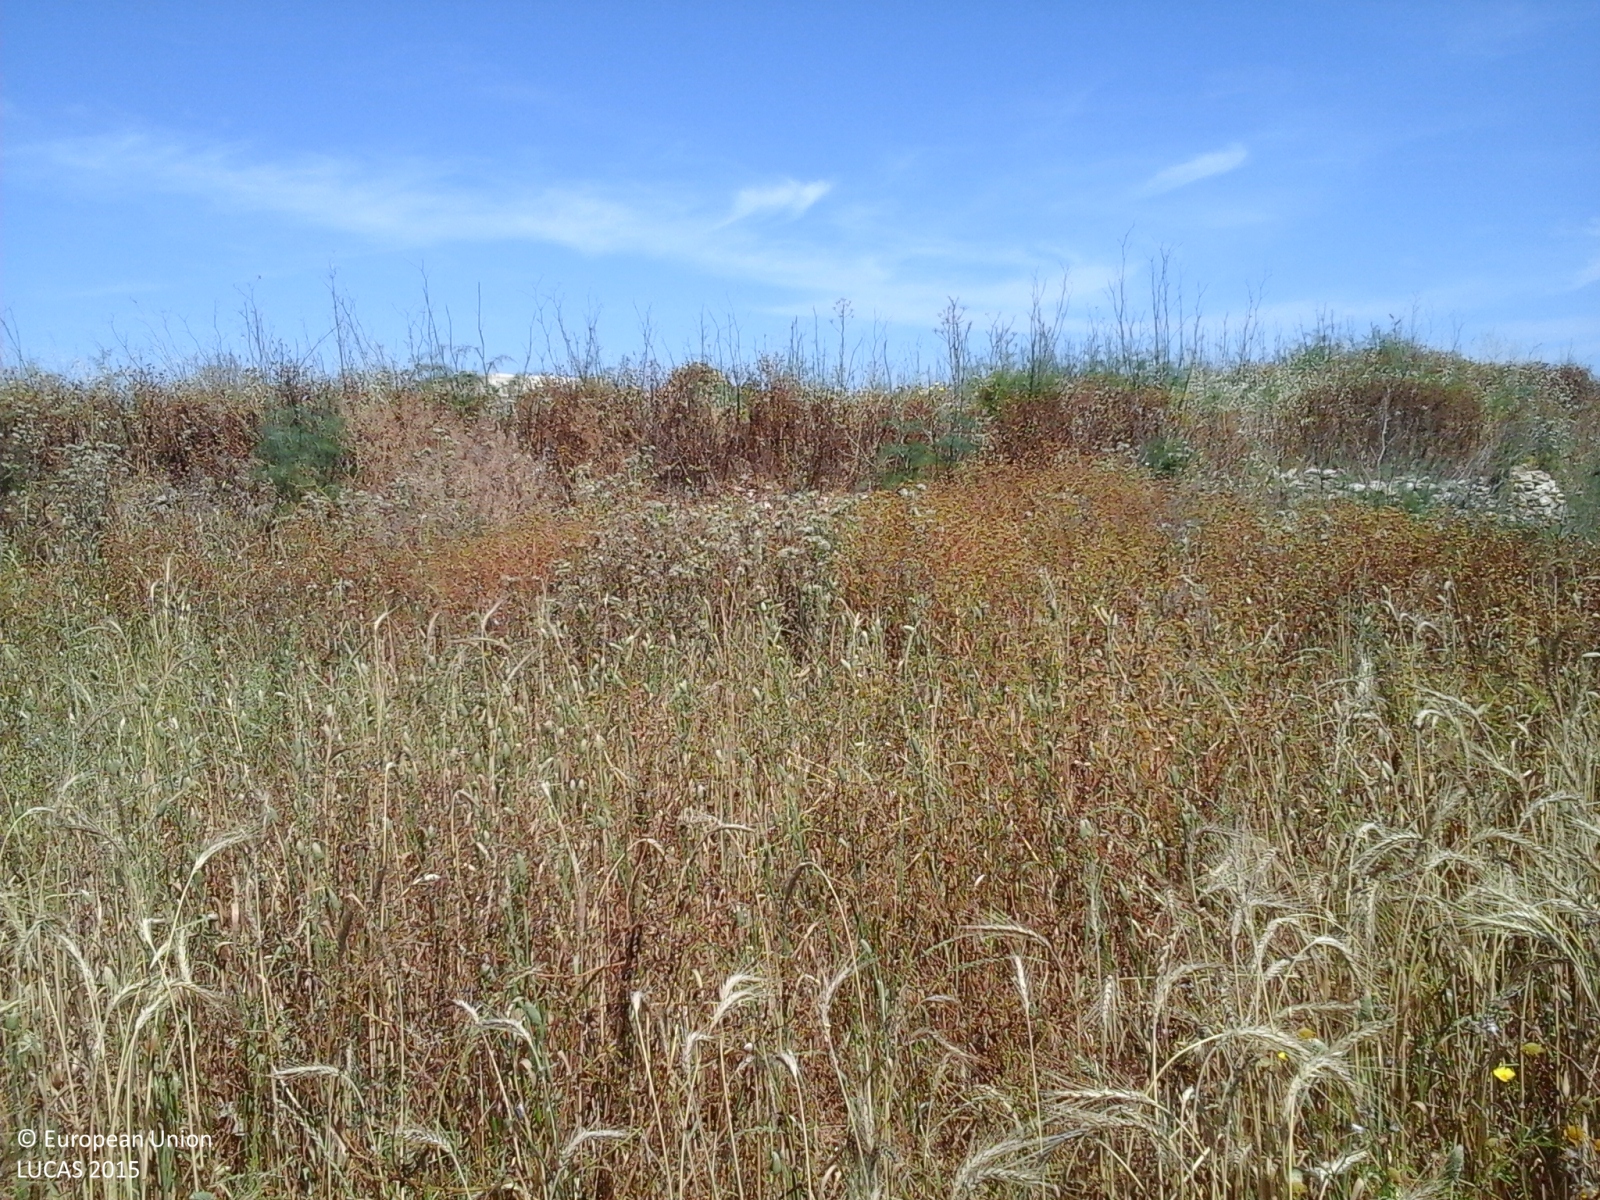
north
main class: Cropland
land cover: Triticale
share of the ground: > 75 %
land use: Agriculture (excluding fallow land and kitchen gardens)
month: May
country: MT
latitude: 36.0693
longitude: 14.2583
